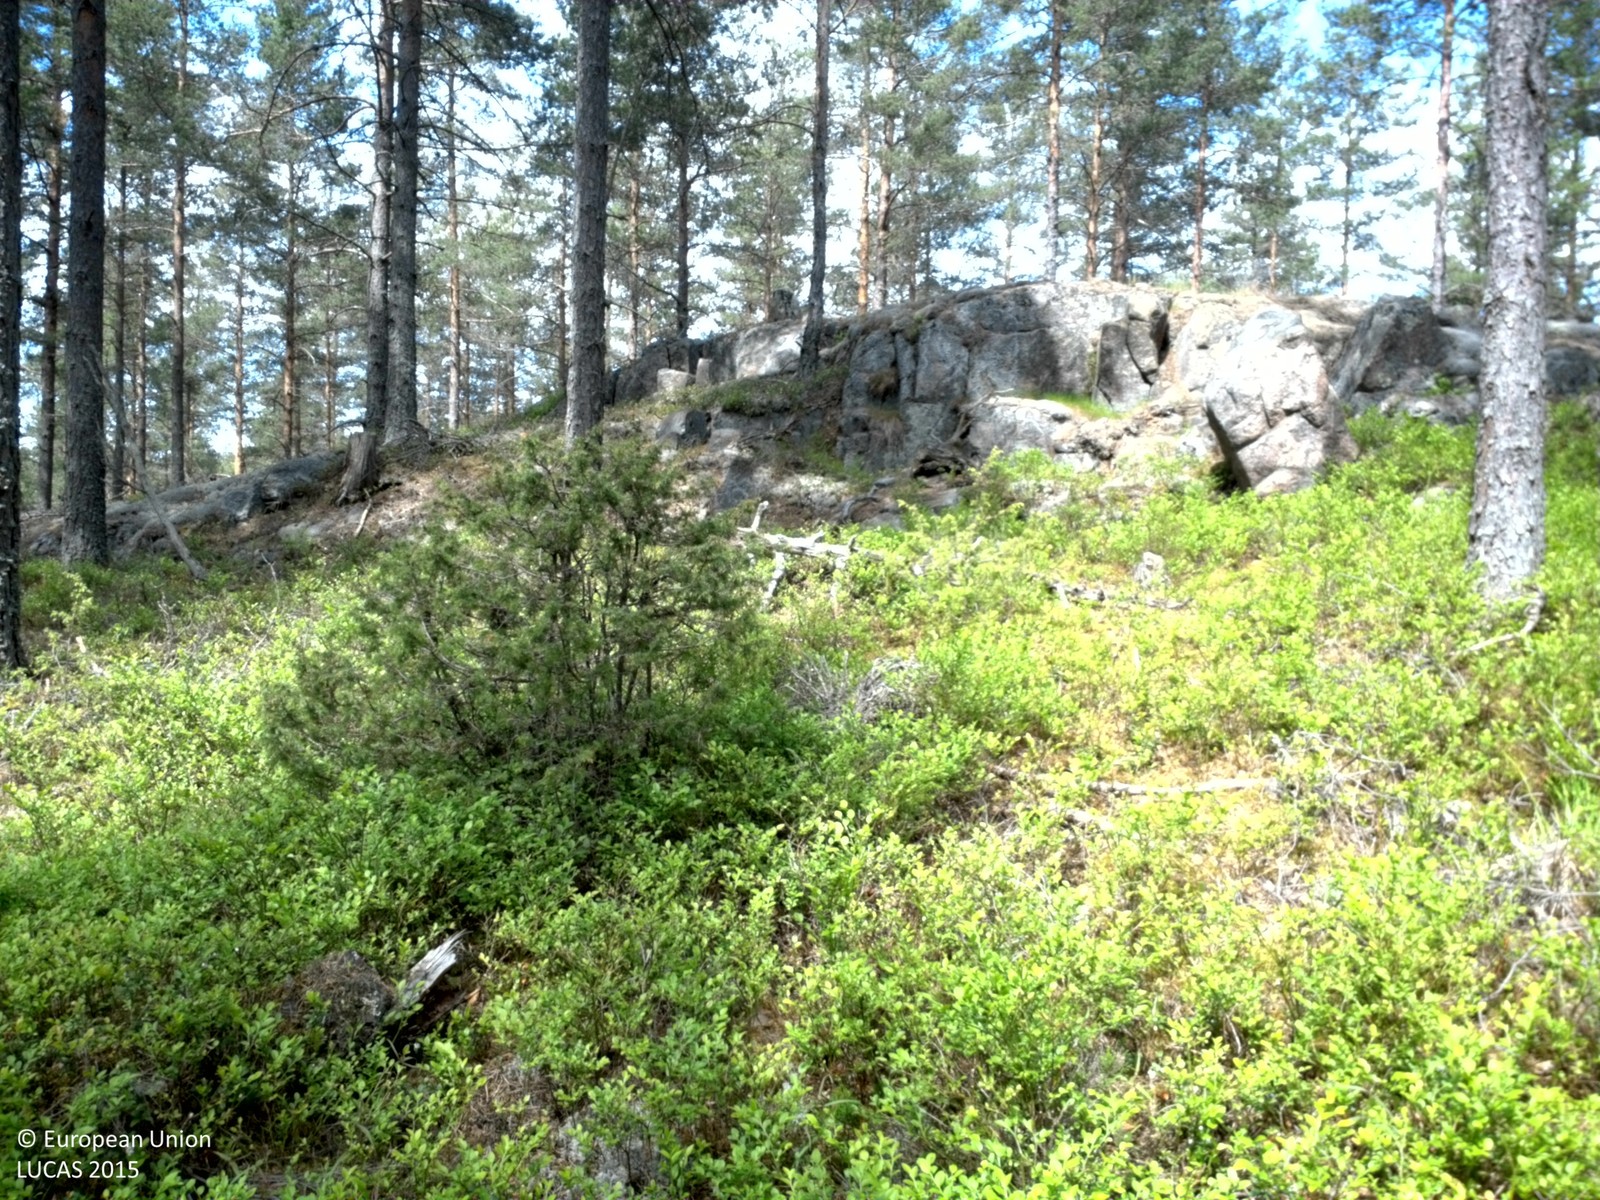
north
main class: Woodland
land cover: Pine dominated coniferous woodland
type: boreal forest
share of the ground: 10 - 25 %
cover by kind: herbaceous plants 40 %, lichens and mosses 40 %, coniferous forest trees 20 %
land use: Forestry
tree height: > 5 m
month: June
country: SE
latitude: 58.7038
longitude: 16.2946
